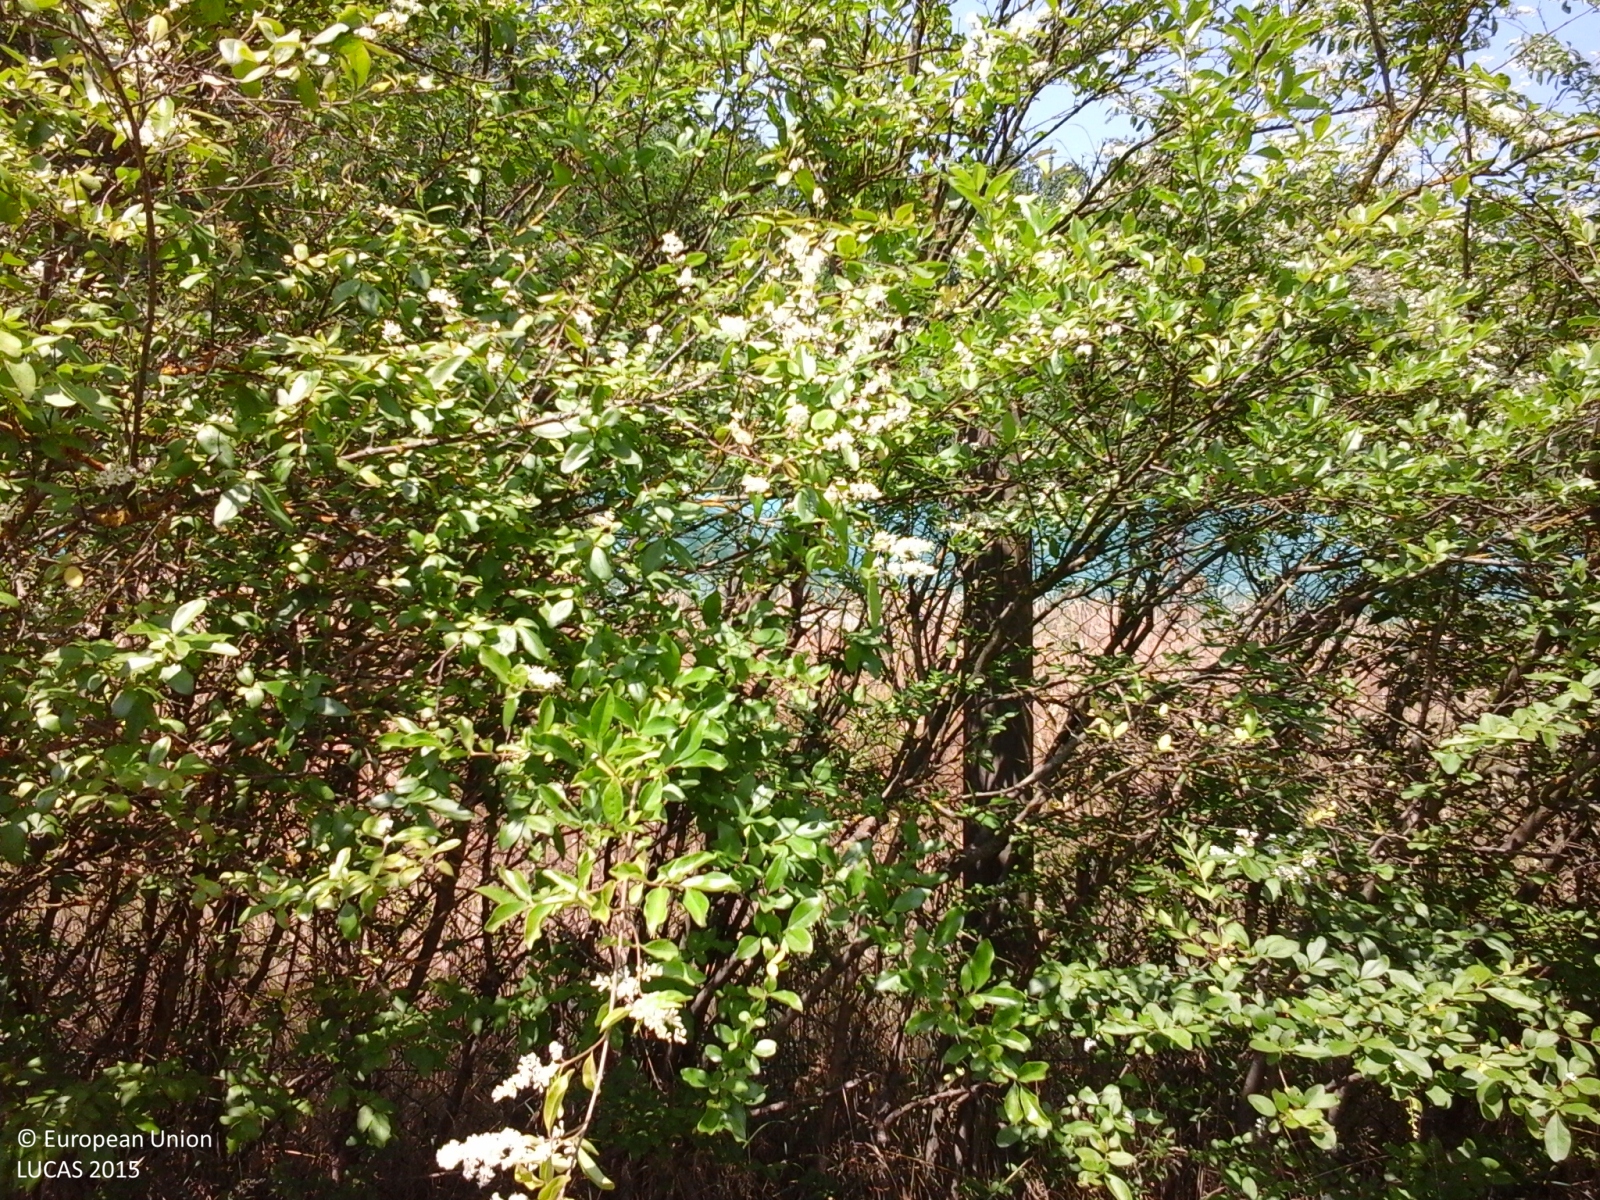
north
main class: Grassland
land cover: Spontaneously vegetated surfaces
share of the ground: > 75 %
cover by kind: herbaceous plants 100 %
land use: Abandoned areas
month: June
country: IT
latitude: 44.7206
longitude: 8.6519
